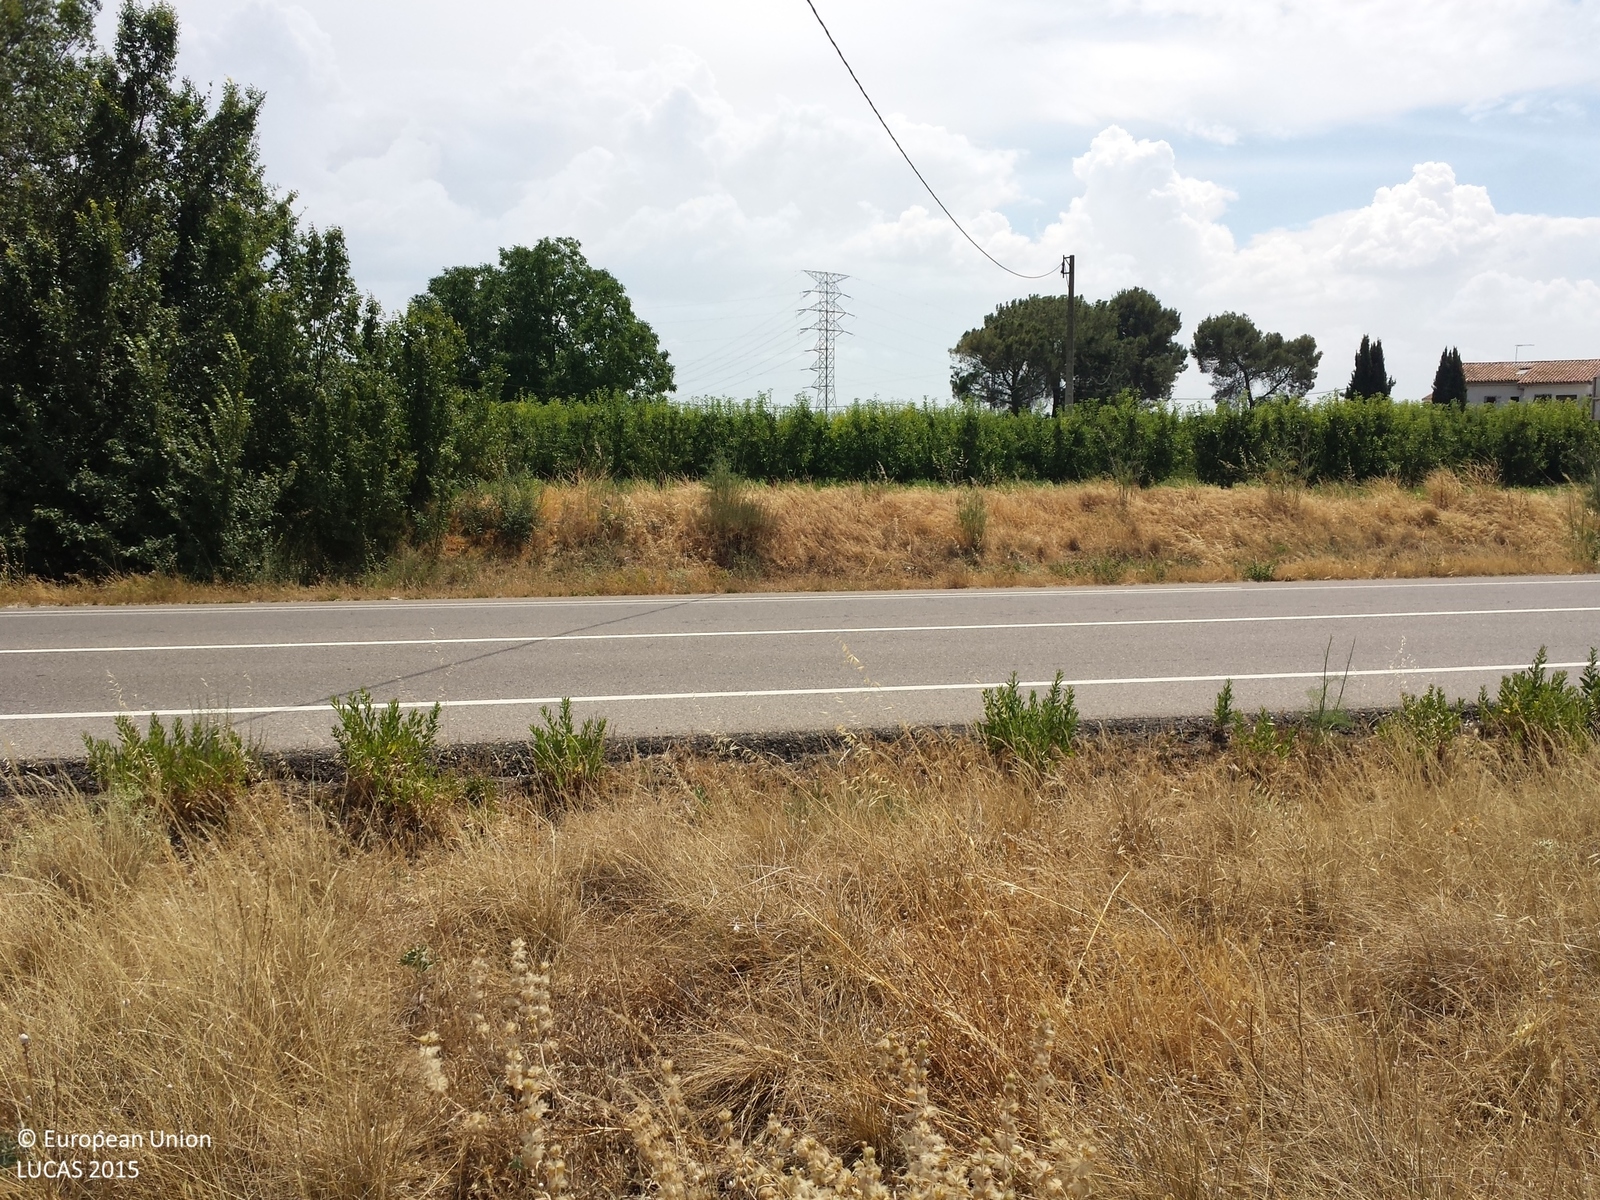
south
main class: Grassland
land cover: Grassland without tree/shrub cover
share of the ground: > 75 %
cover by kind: herbaceous plants 85 %, consolidated bare surface 10 %, shrubs 5 %
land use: Semi-natural and natural areas not in use
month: June
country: ES
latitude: 41.5818
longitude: 0.6202
